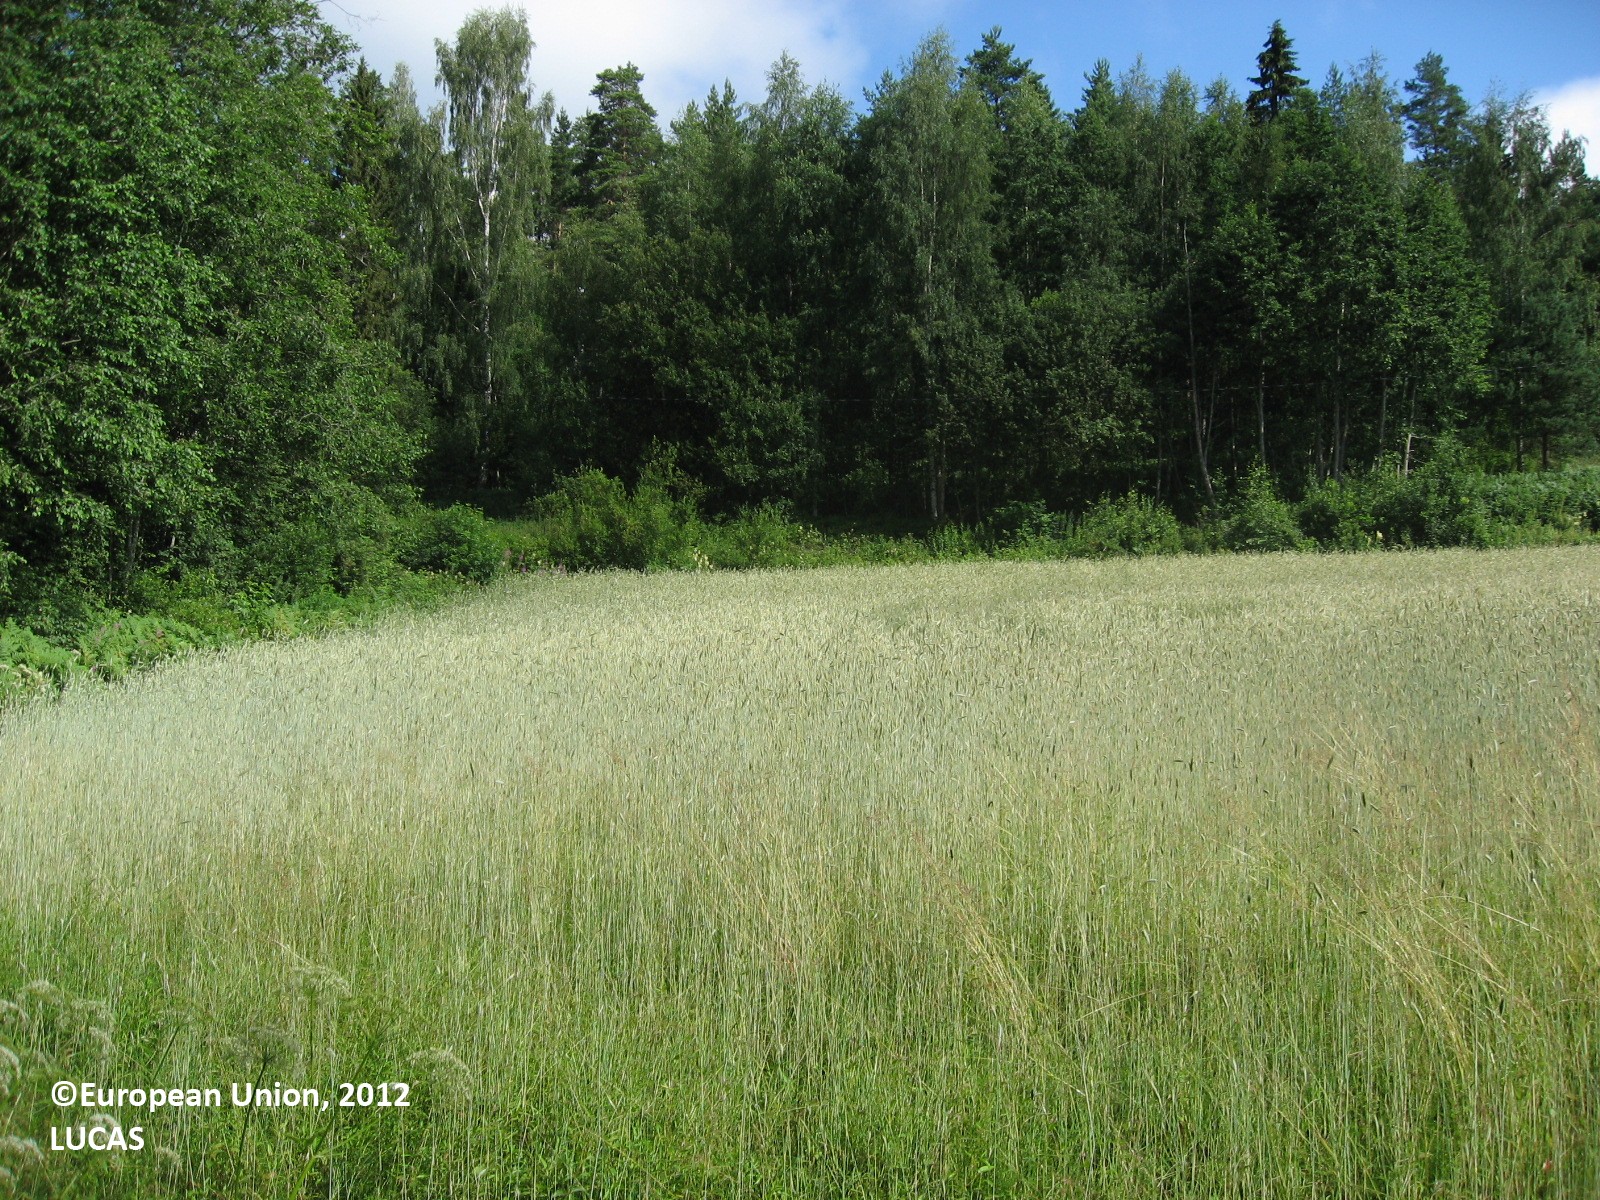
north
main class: Shrubland
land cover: Shrubland with sparse tree cover
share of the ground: > 75 %
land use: Semi-natural and natural areas not in use
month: July
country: FI
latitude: 61.1382
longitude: 25.6729
